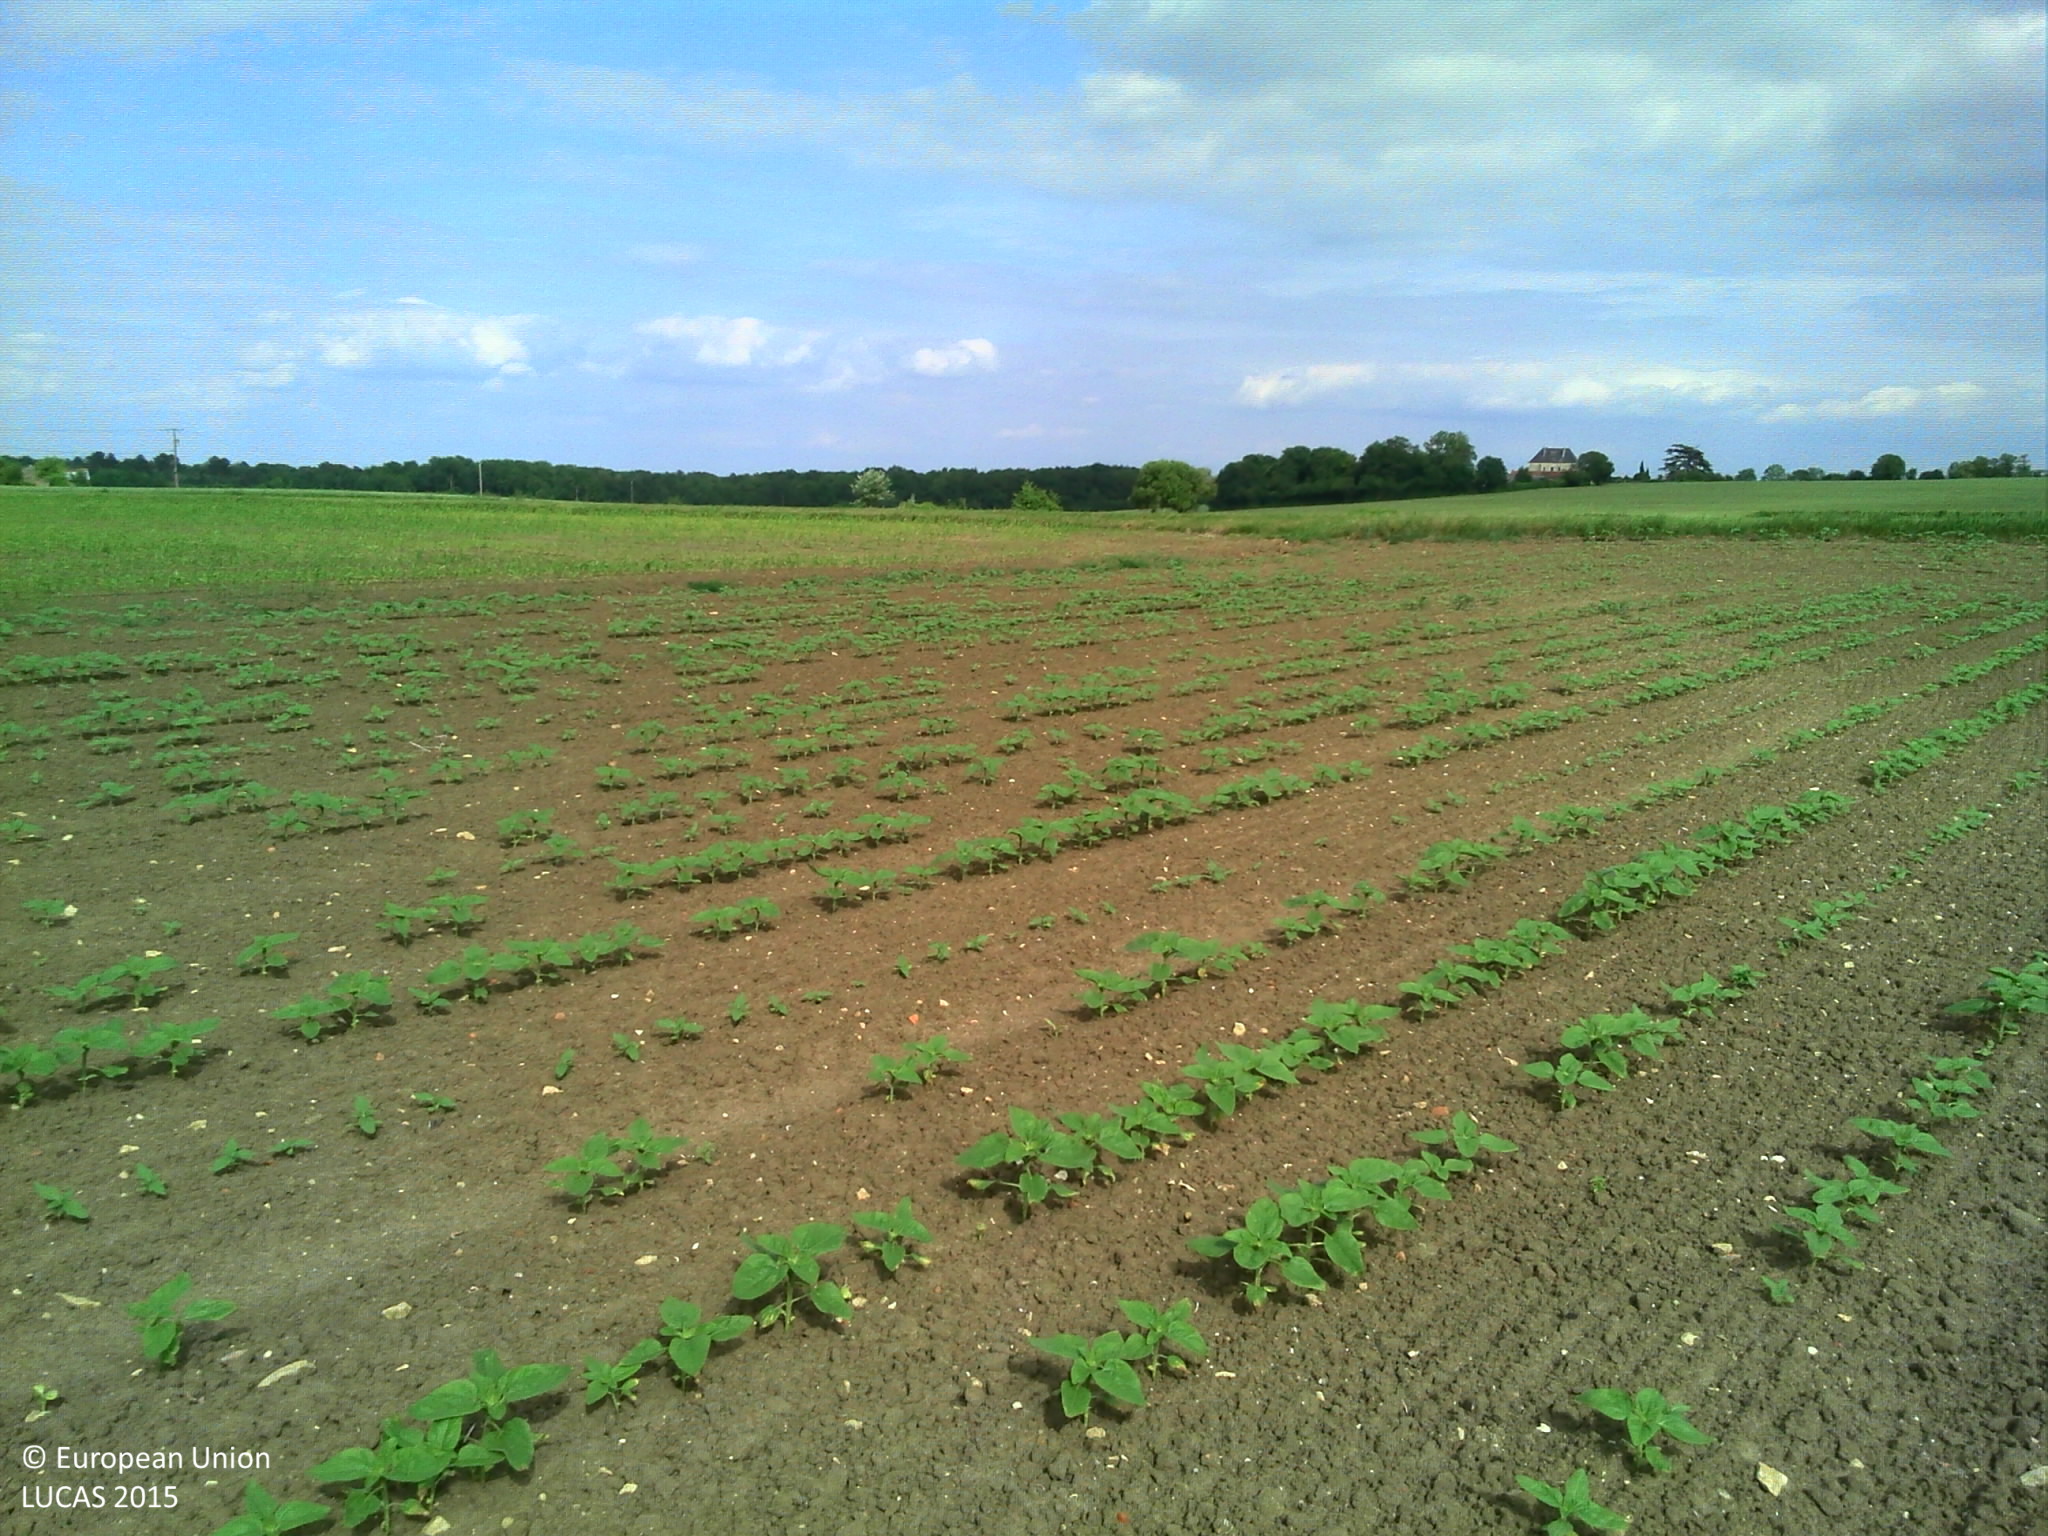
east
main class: Cropland
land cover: Sunflower
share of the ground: 10 - 25 %
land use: Agriculture (excluding fallow land and kitchen gardens)
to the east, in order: Sunflower; Electric lines; Maize; Grass margins; Tracks; Grass margins; Maize
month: May
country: FR
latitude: 46.8286
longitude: 0.2387
